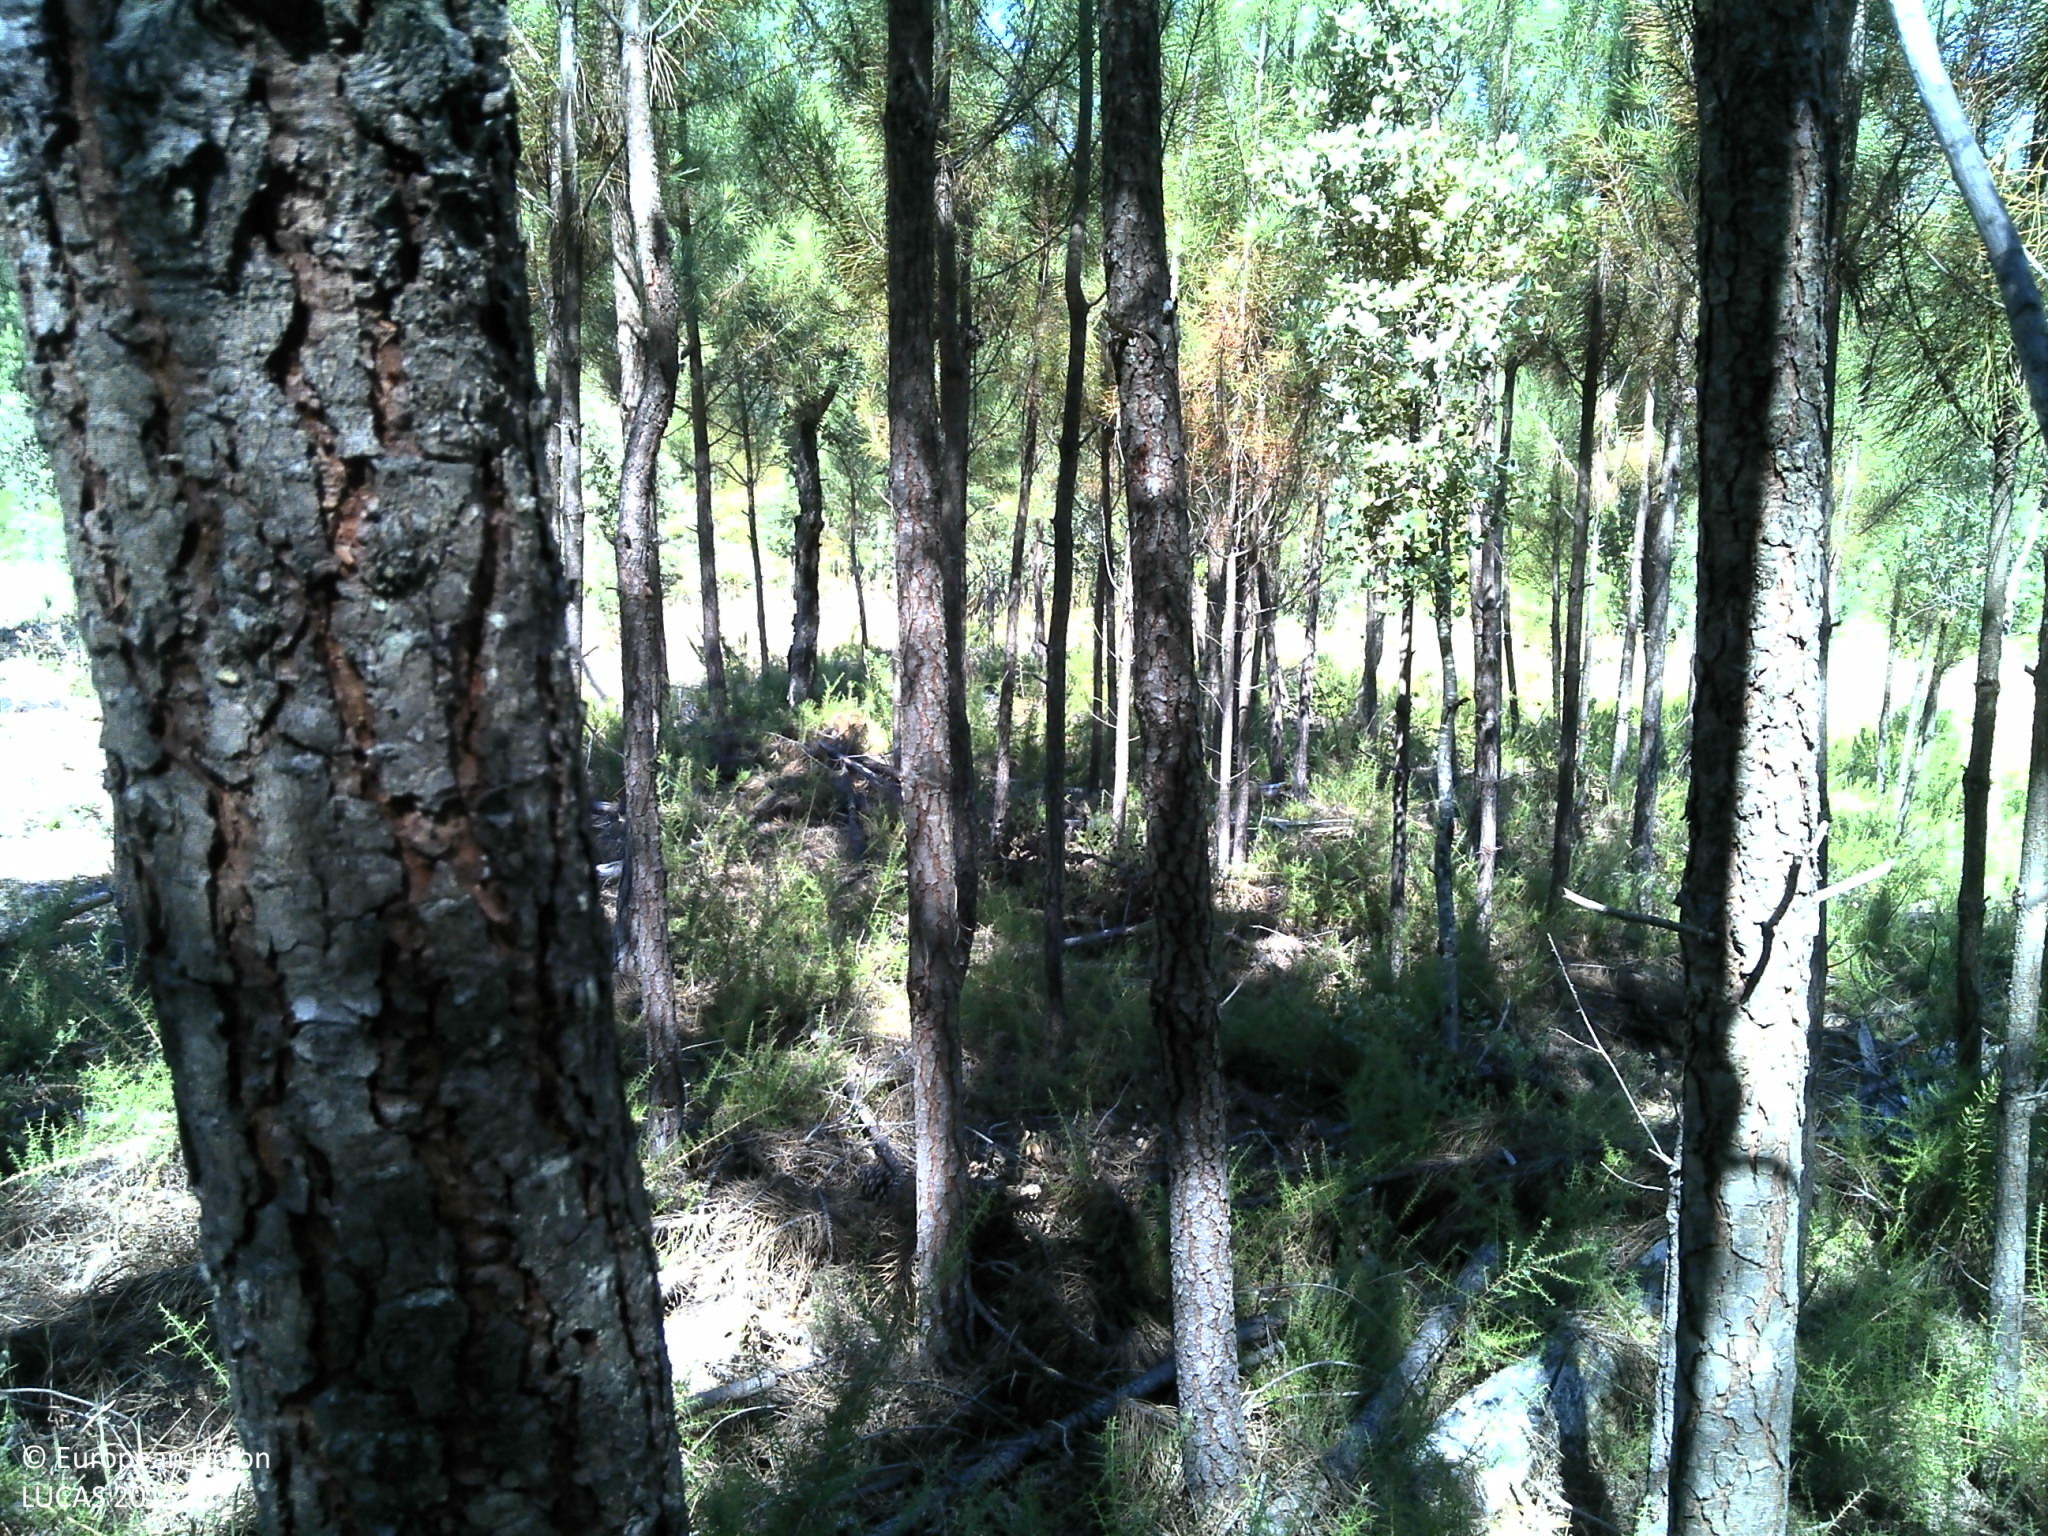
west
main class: Woodland
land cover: Pine dominated coniferous woodland
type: coniferous forest of the mediterranean region
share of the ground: 50 - 75 %
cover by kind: coniferous forest trees 50 %, shrubs 20 %, unconsolidated bare surface 10 %
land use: Forestry
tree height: > 5 m
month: July
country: PT
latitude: 39.7252
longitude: -8.1386
